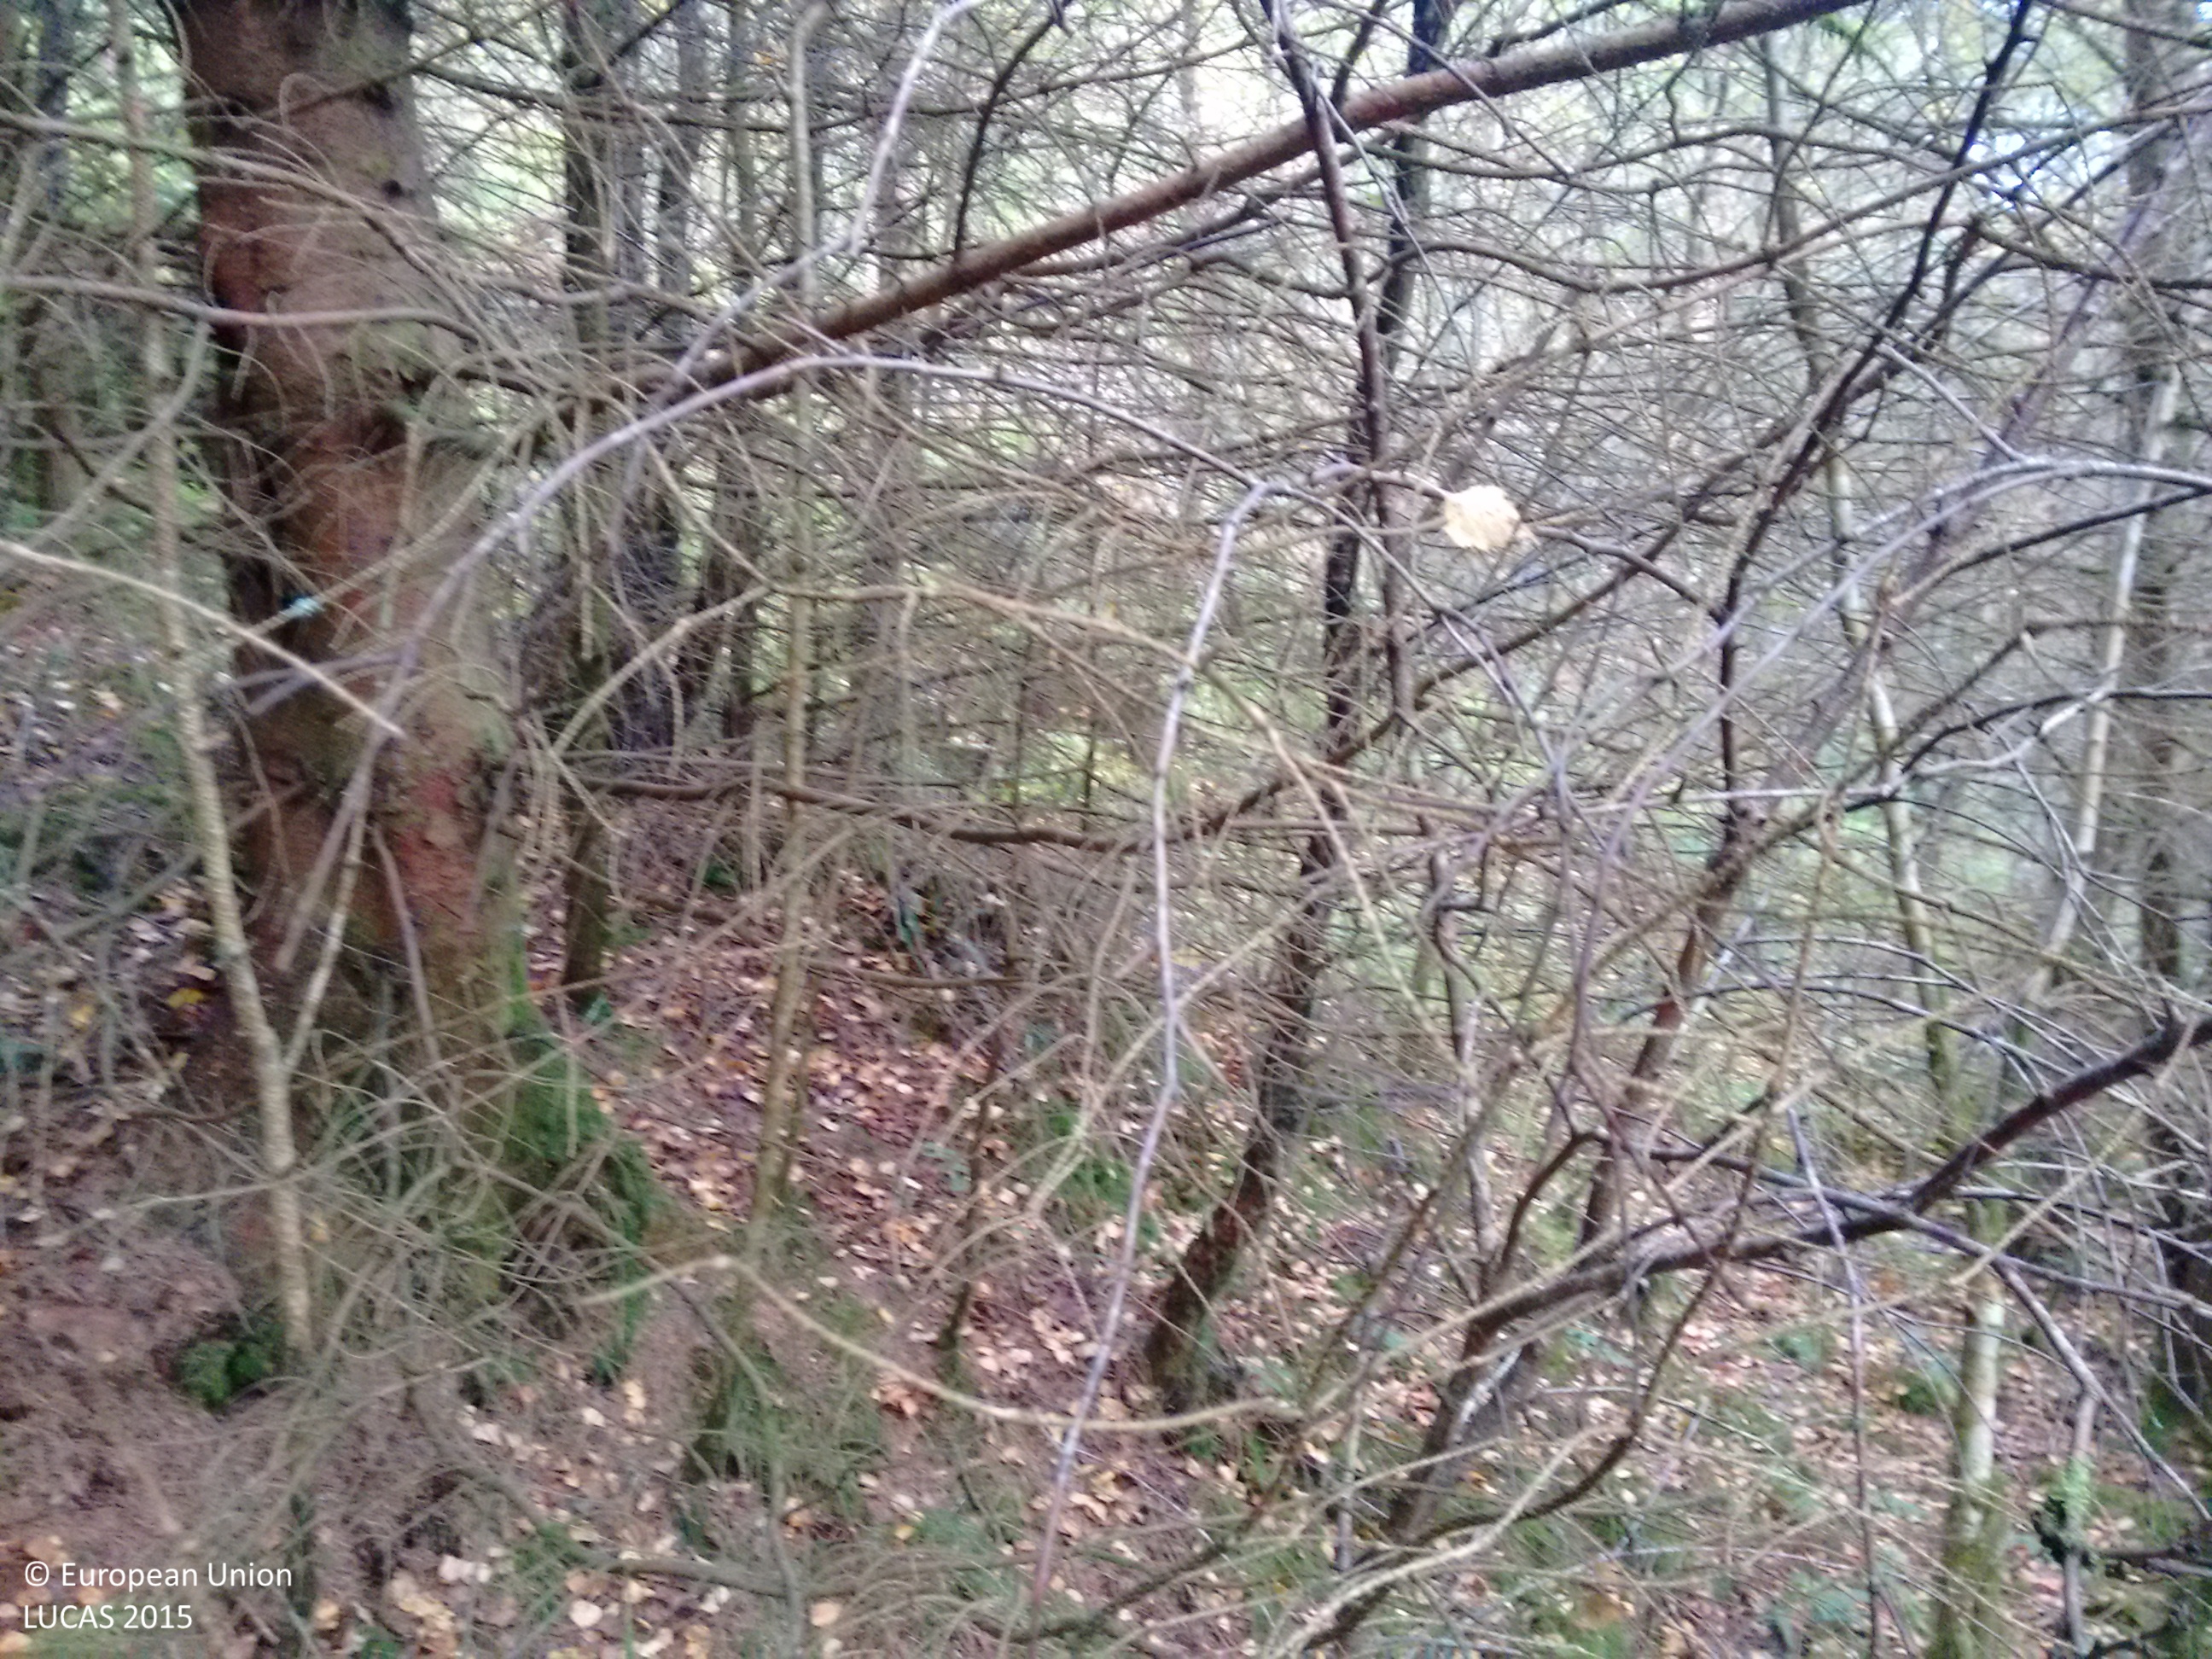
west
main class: Woodland
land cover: Pine dominated coniferous woodland
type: exotic forest
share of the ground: > 75 %
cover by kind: coniferous forest trees 100 %
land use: Forestry
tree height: > 5 m
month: October
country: GB
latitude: 52.5217
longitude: -3.9020
